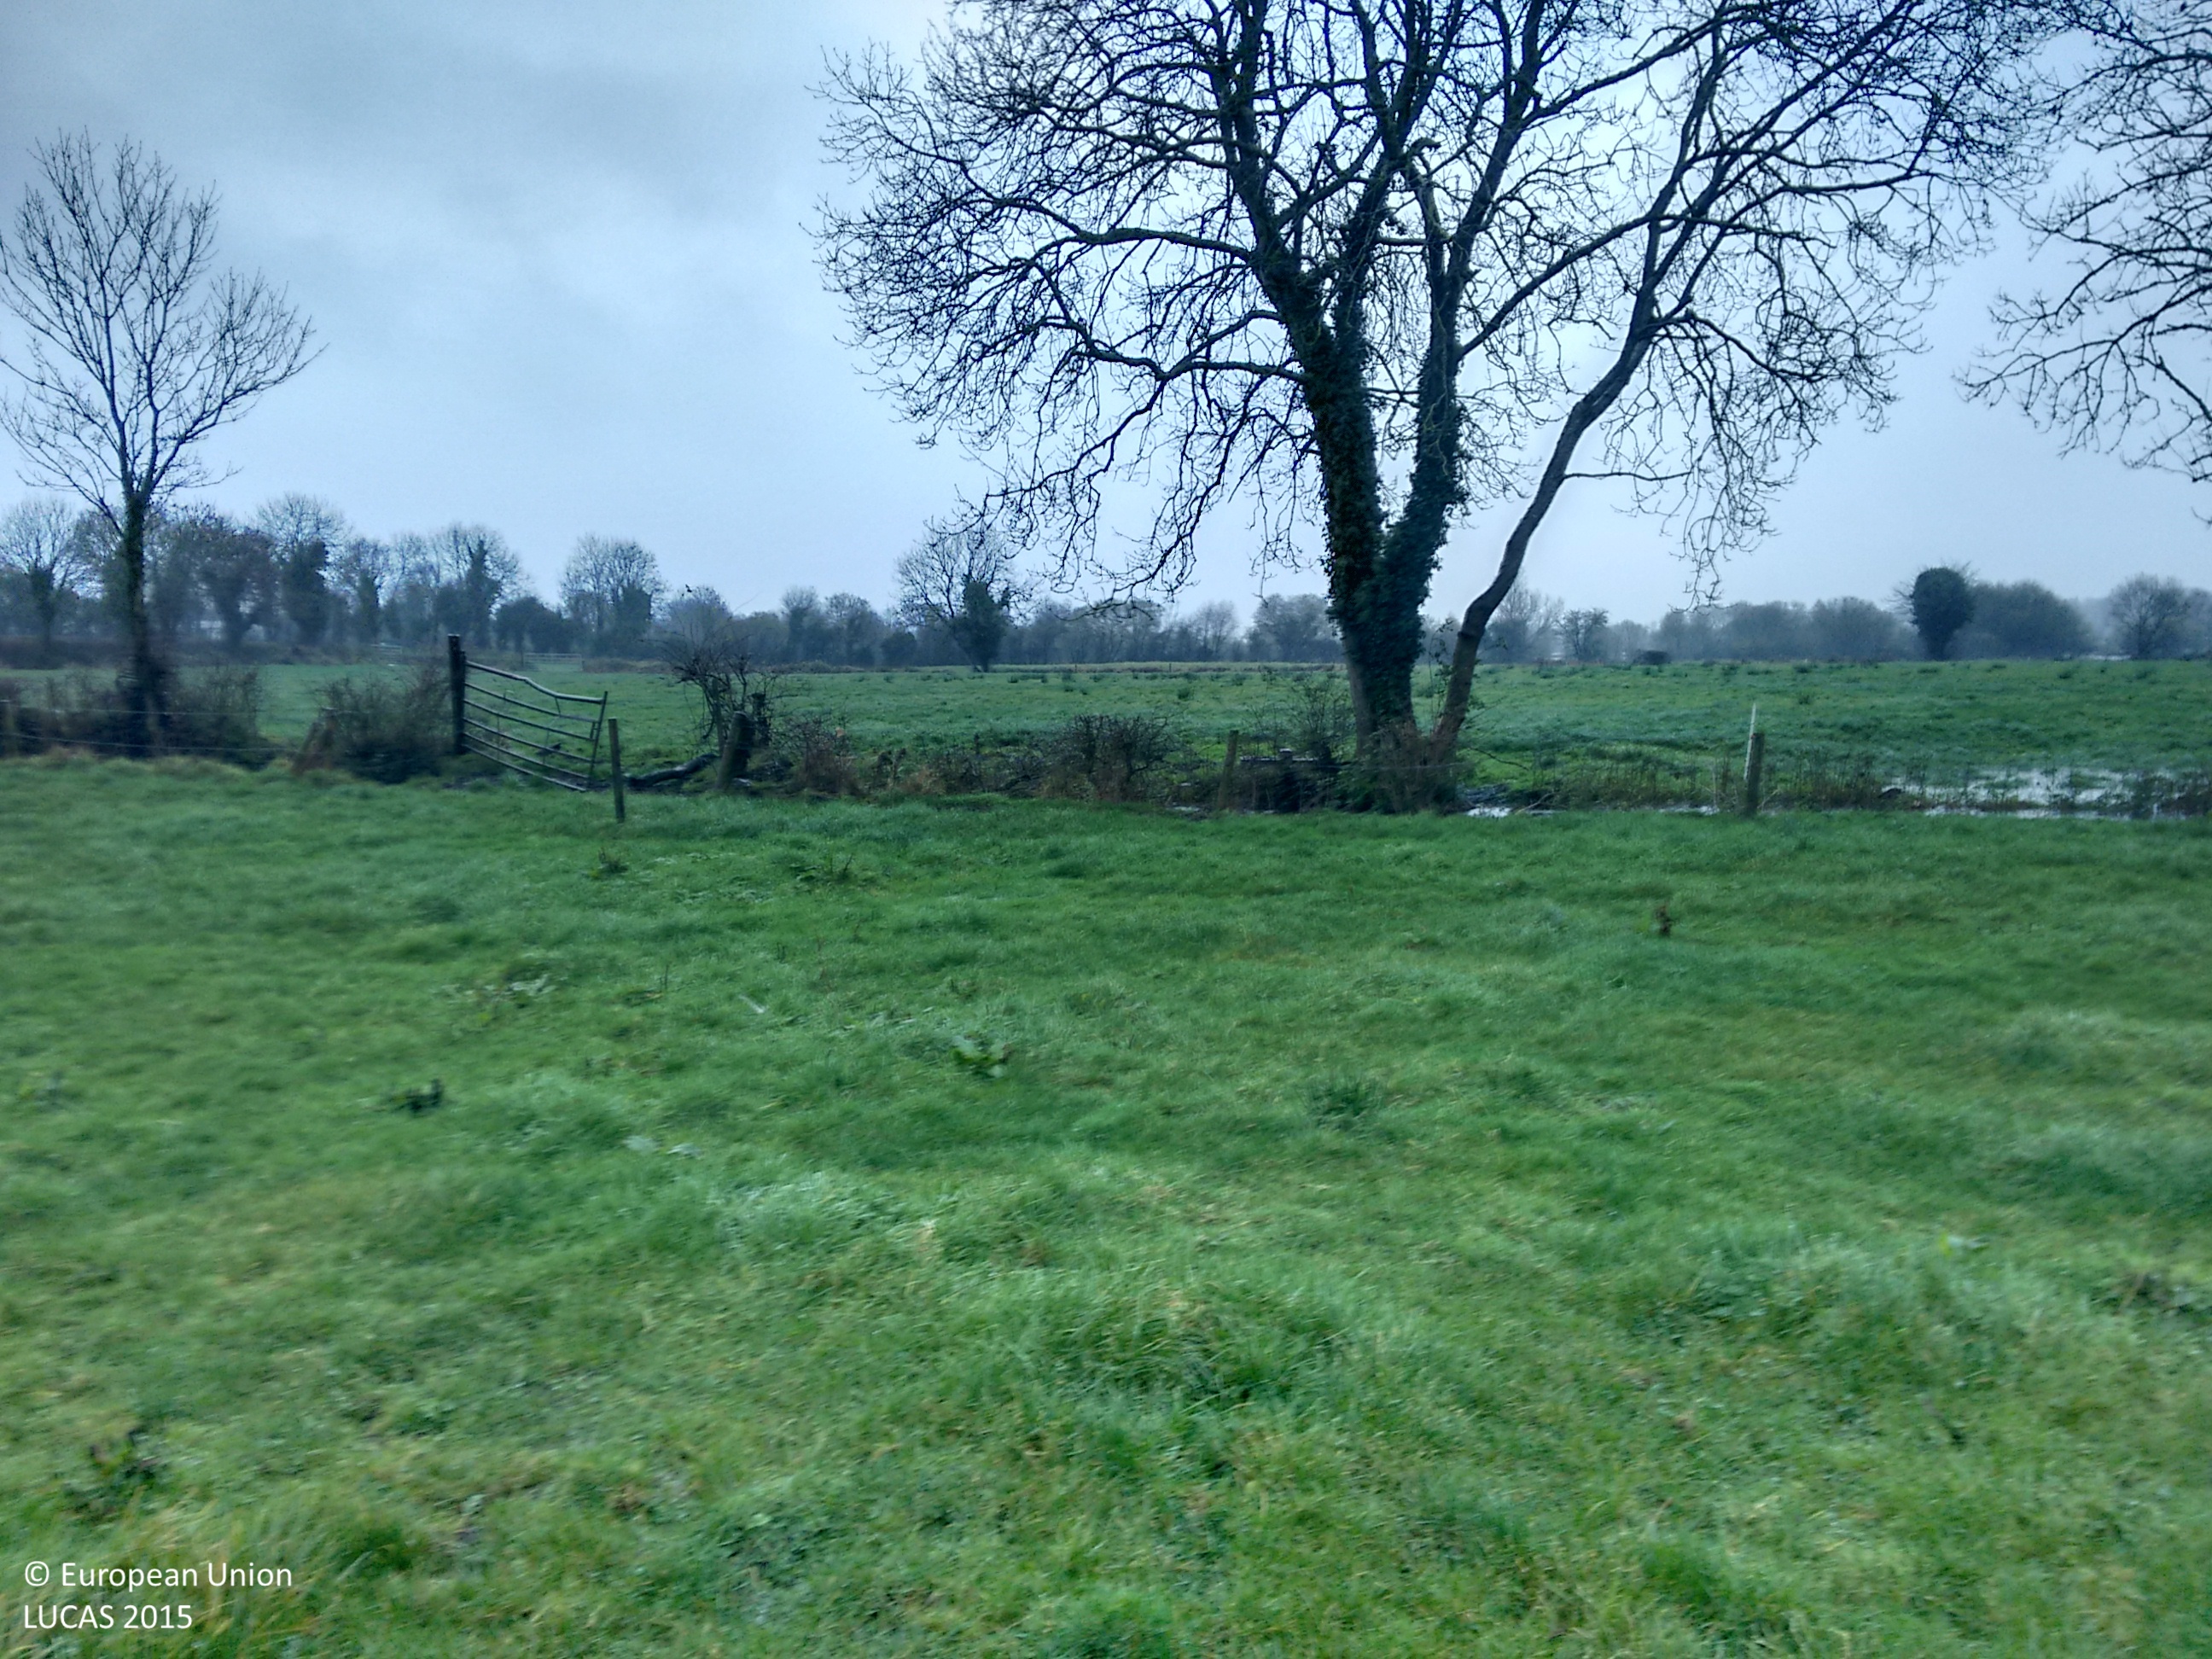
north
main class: Grassland
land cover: Grassland without tree/shrub cover
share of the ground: > 75 %
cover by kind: herbaceous plants 95 %
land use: Agriculture (excluding fallow land and kitchen gardens)
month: November
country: IE
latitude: 53.8494
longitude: -7.8477
